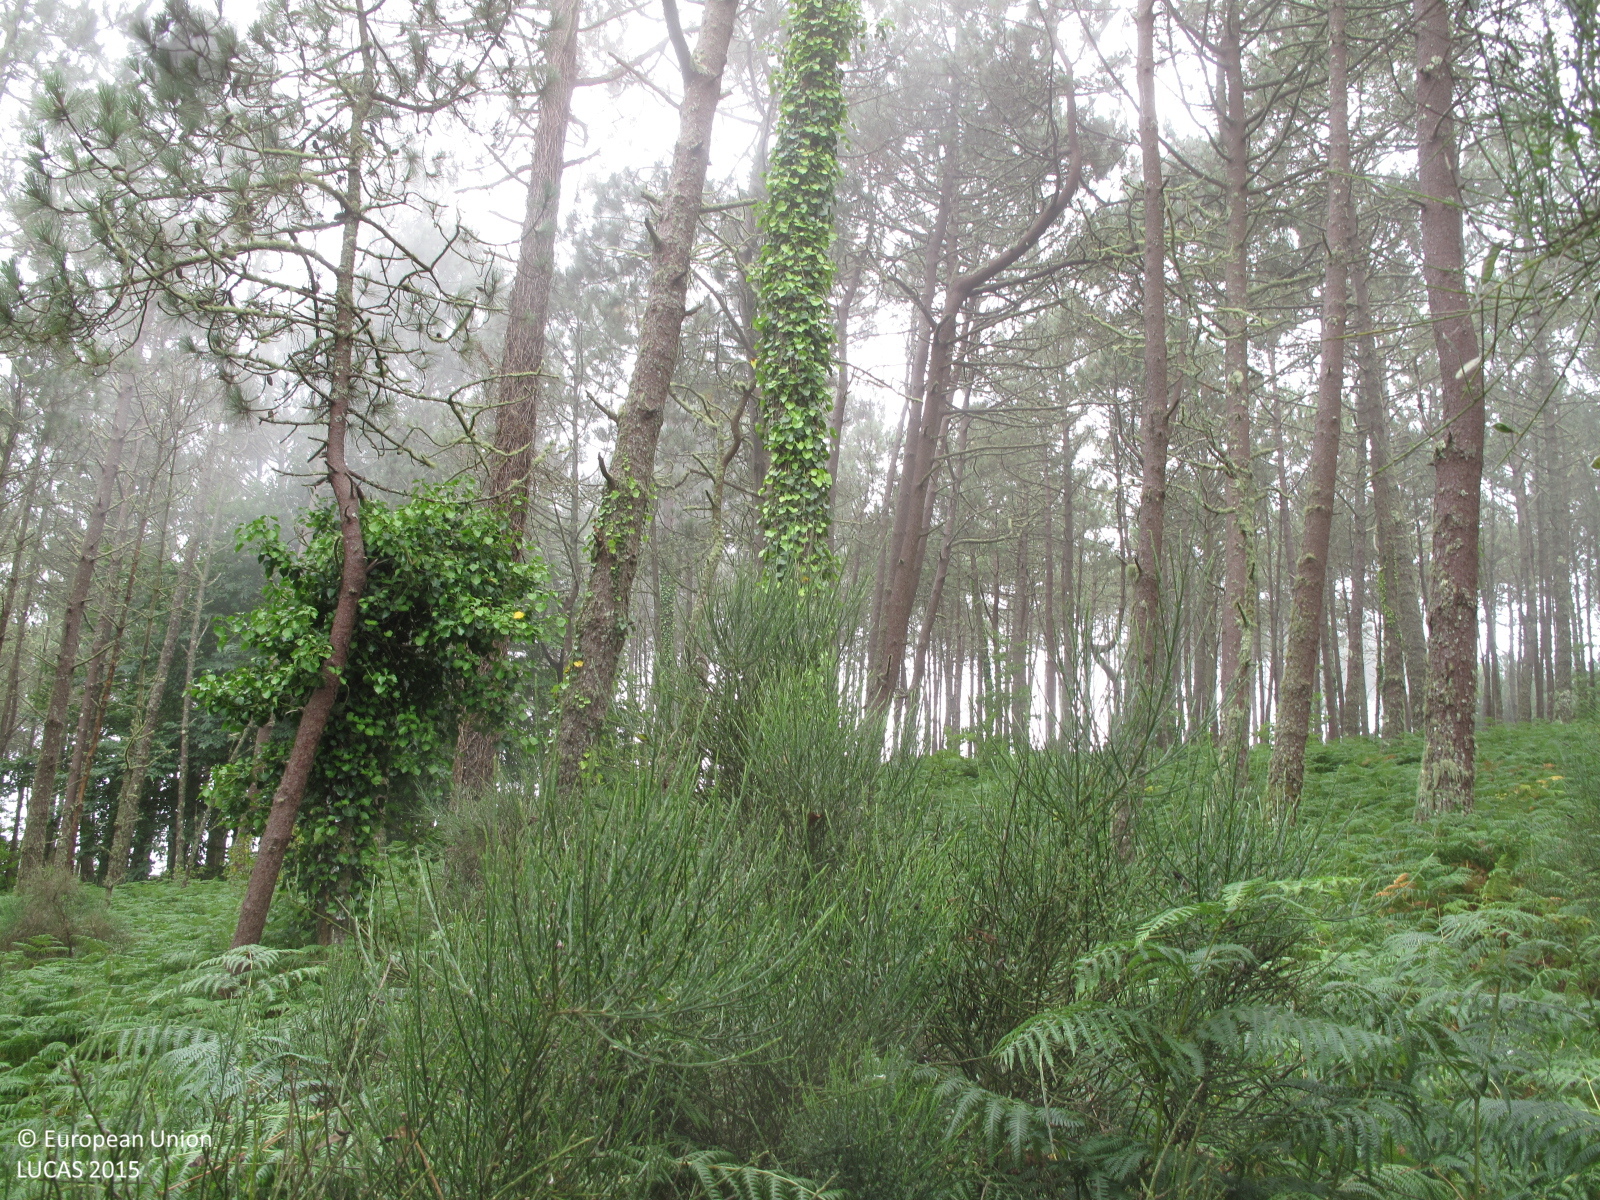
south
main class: Woodland
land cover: Pine dominated coniferous woodland
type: hemiboreal forest and nemoral coniferous forest and mixed broadleaved-coniferous forest
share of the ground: 50 - 75 %
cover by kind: coniferous forest trees 65 %, herbaceous plants 20 %, shrubs 10 %, broadleaved forest trees 5 %
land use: Forestry
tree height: > 5 m
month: July
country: ES
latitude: 42.9282
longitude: -9.2802
